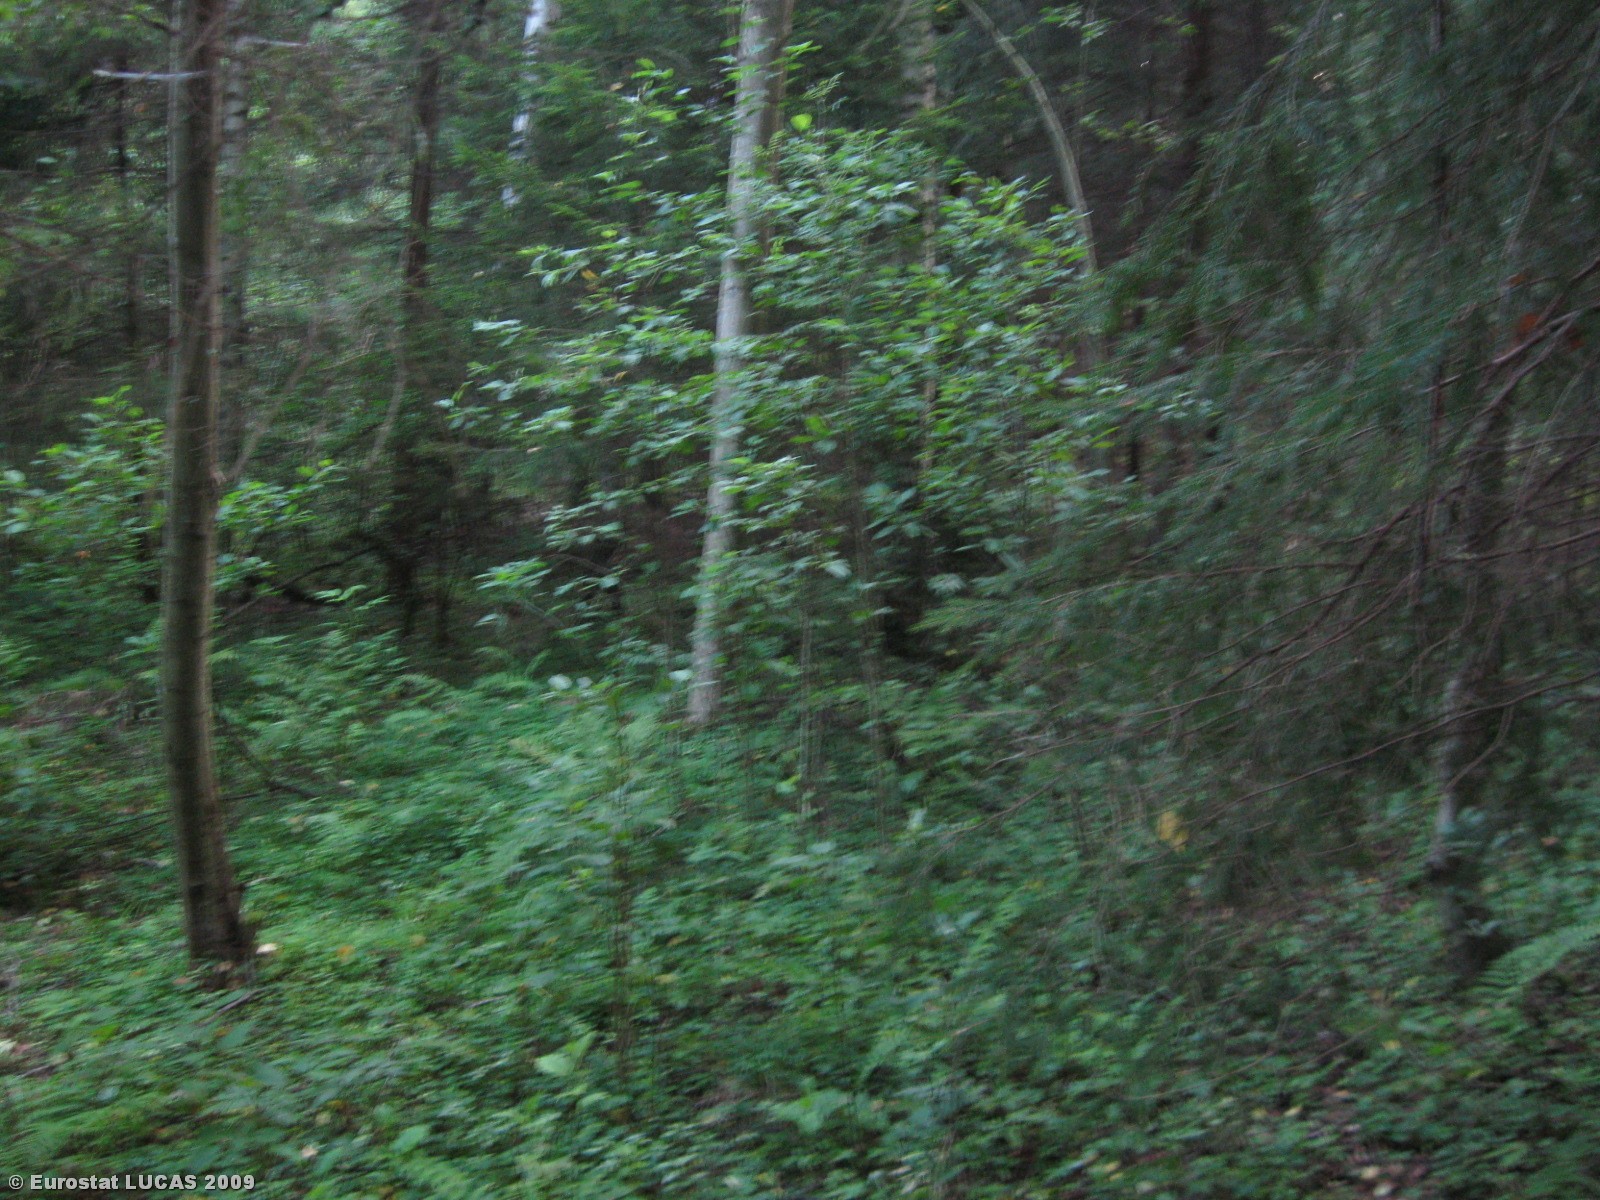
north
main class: Woodland
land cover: Mixed woodland
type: hemiboreal forest and nemoral coniferous forest and mixed broadleaved-coniferous forest
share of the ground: > 75 %
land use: Forestry
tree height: > 5 m
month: August
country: LT
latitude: 55.2504
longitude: 22.6333
